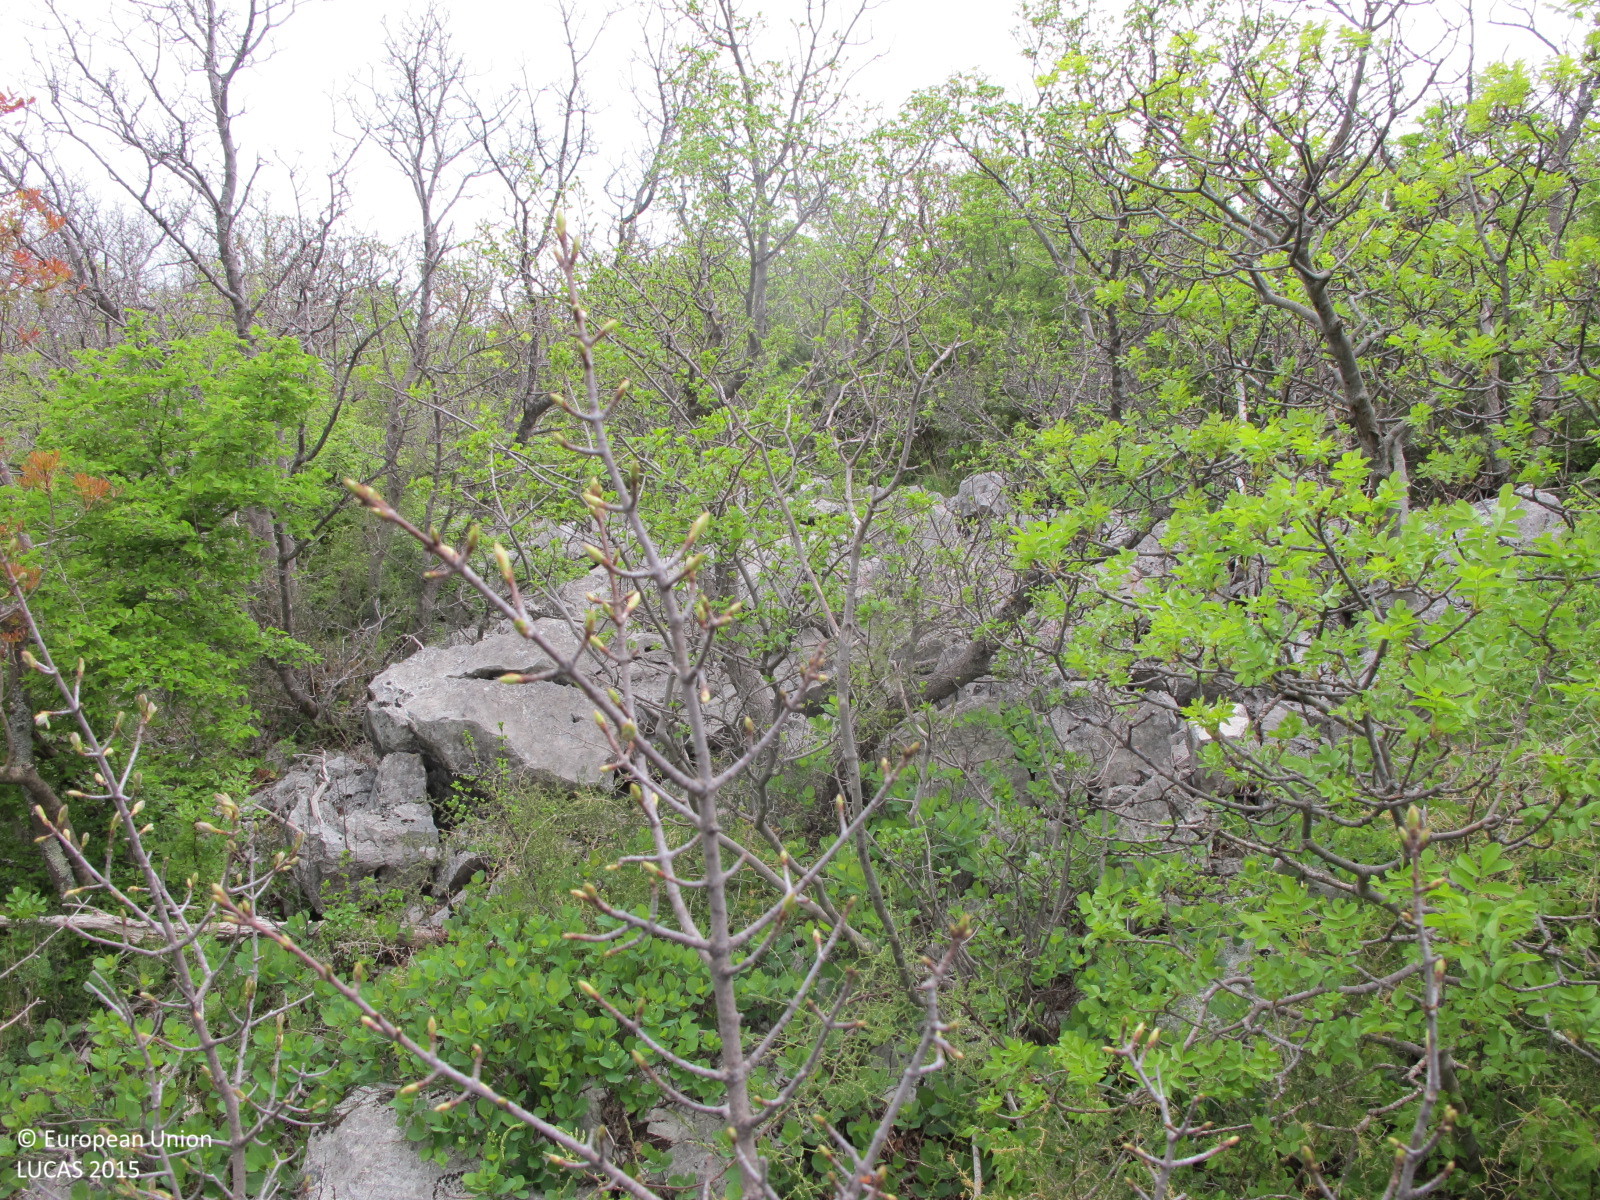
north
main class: Woodland
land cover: Broadleaved woodland
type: thermophilous deciduous forest
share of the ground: > 75 %
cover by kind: broadleaved forest trees 75 %, shrubs 20 %
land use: Semi-natural and natural areas not in use
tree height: < 5 m
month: April
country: HR
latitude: 45.2409
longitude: 14.6192
